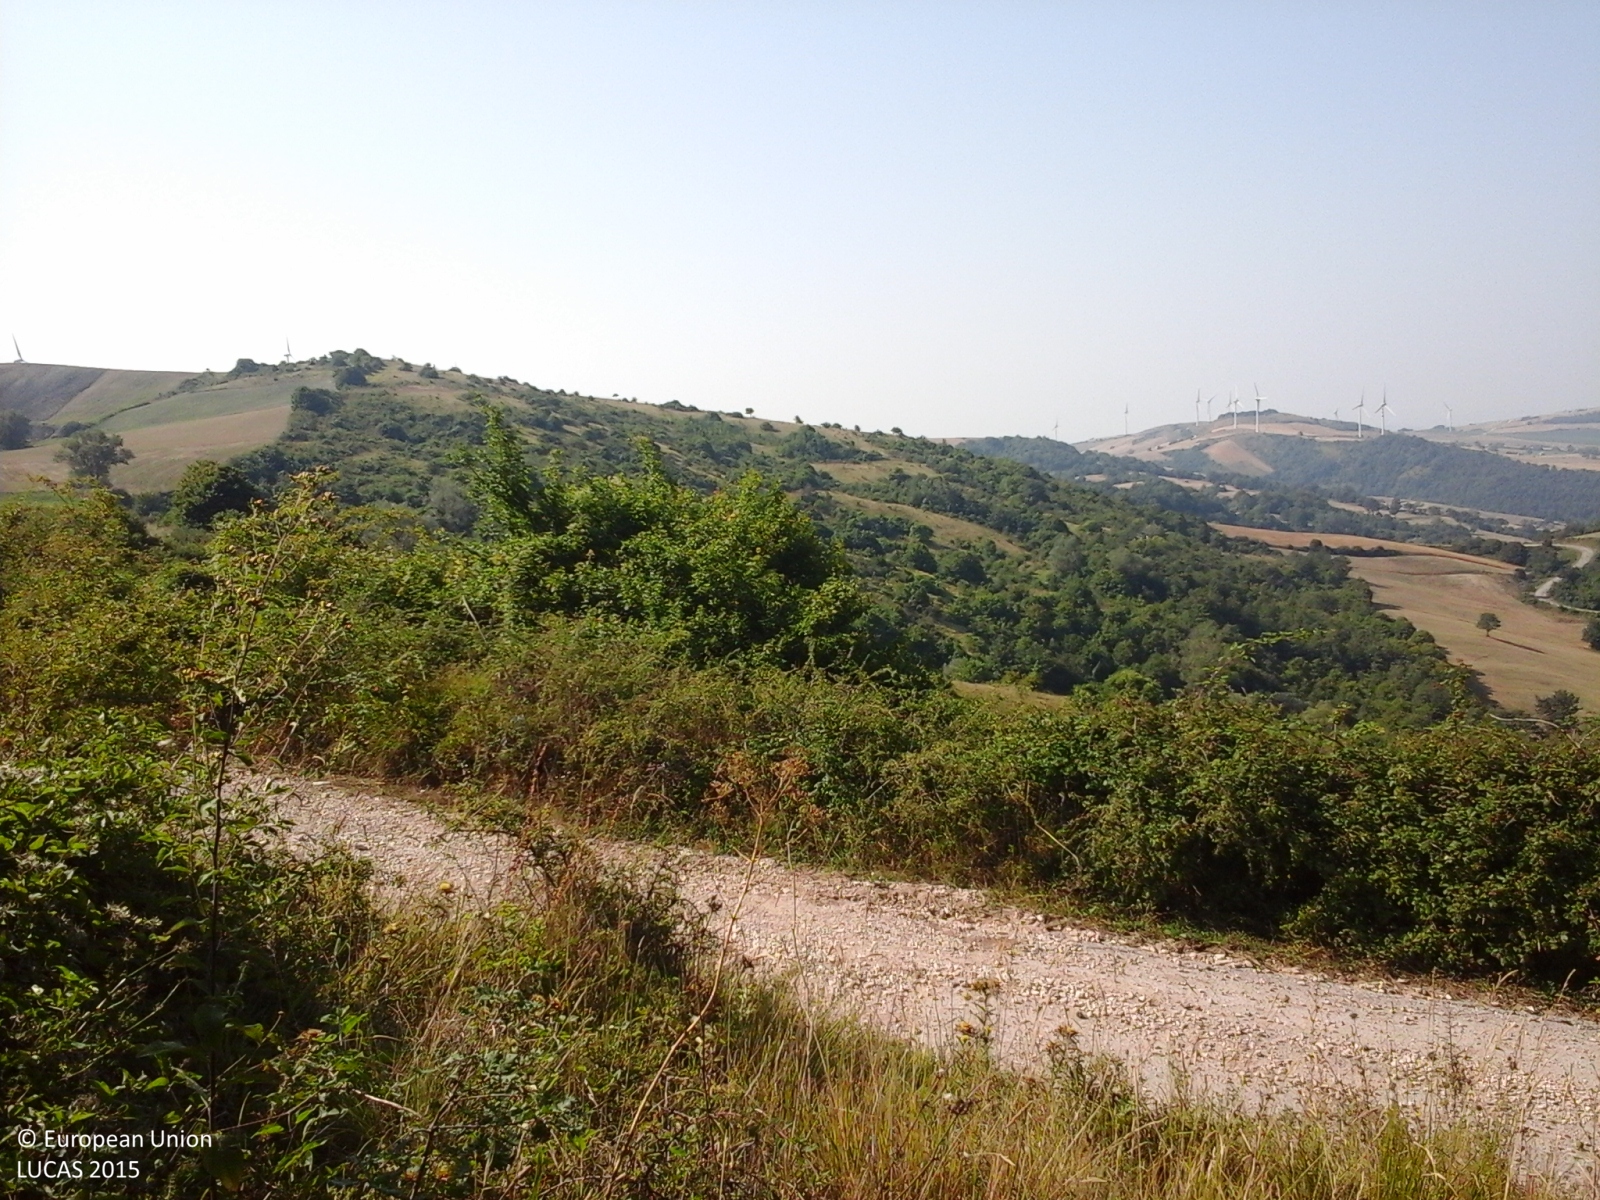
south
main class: Woodland
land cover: Pine dominated coniferous woodland
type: coniferous forest of the mediterranean region
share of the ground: > 75 %
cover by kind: coniferous forest trees 95 %, herbaceous plants 5 %
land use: Semi-natural and natural areas not in use
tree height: > 5 m
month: August
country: IT
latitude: 41.3652
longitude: 15.1346
